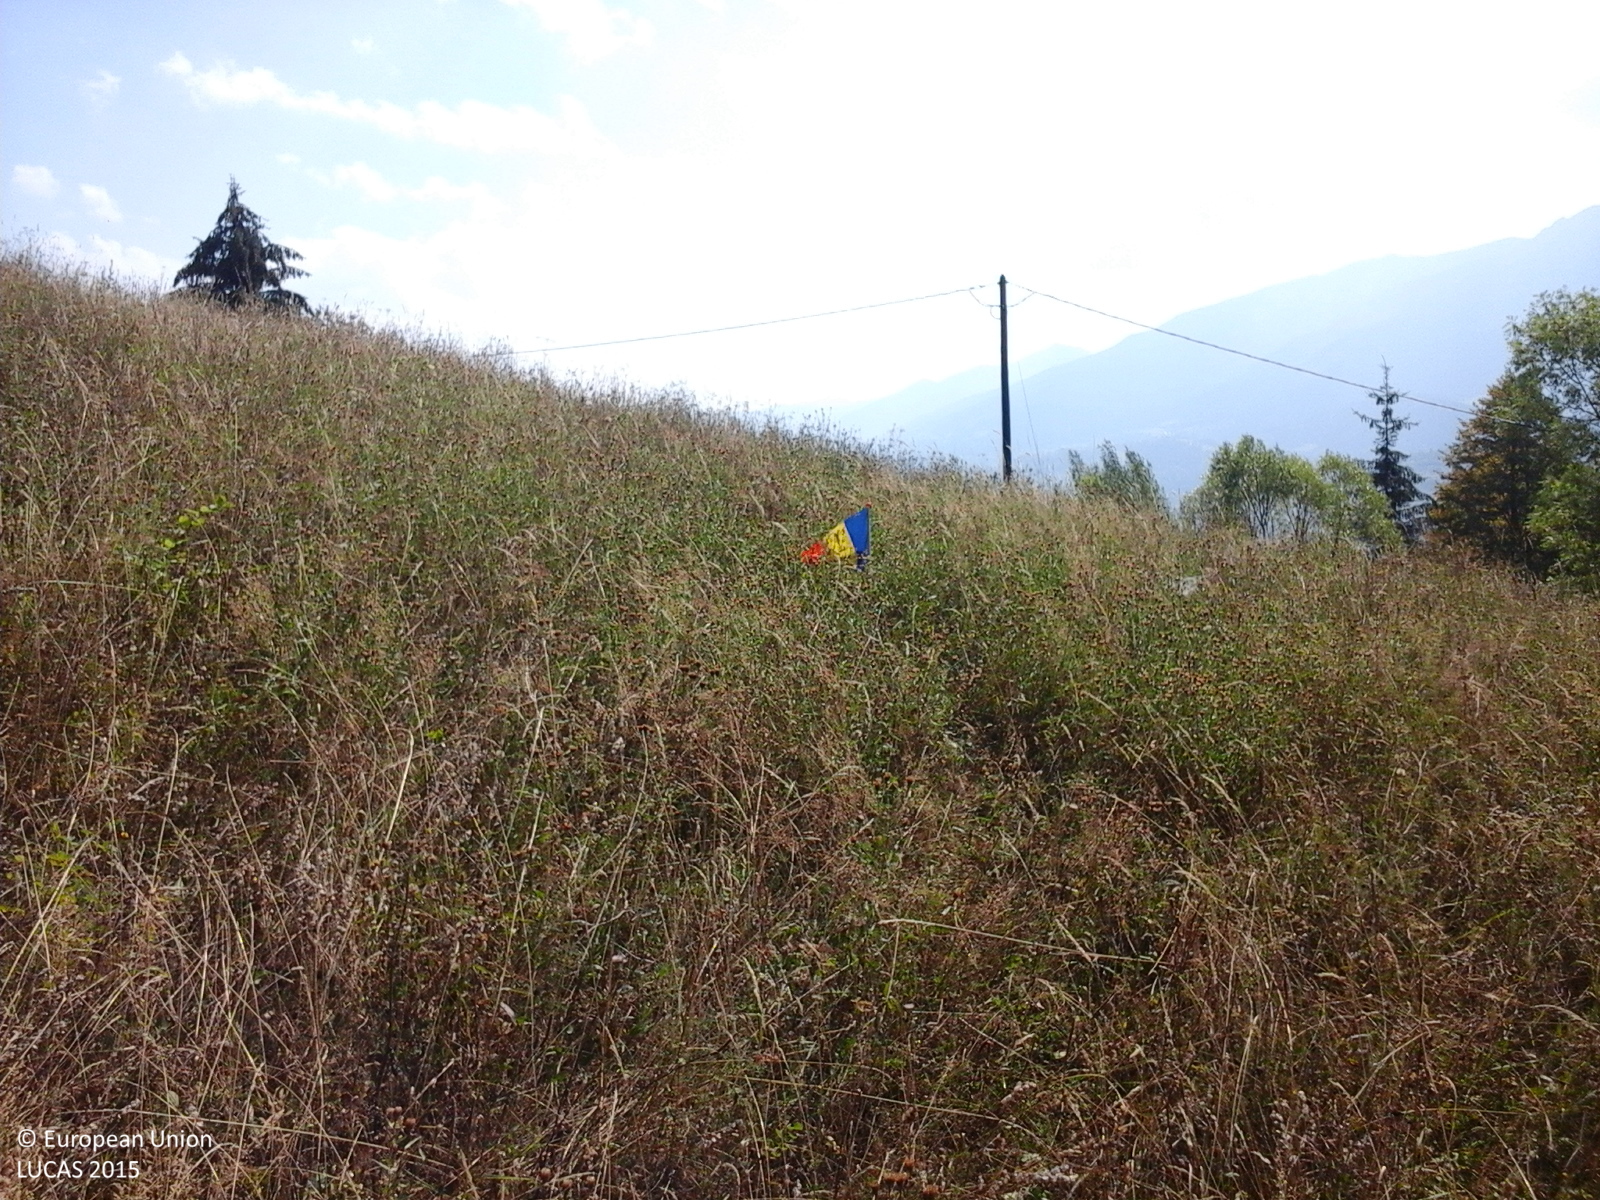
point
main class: Grassland
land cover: Grassland without tree/shrub cover
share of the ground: > 75 %
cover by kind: herbaceous plants 100 %
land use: Agriculture (excluding fallow land and kitchen gardens)
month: September
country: RO
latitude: 47.6691
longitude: 24.5726
